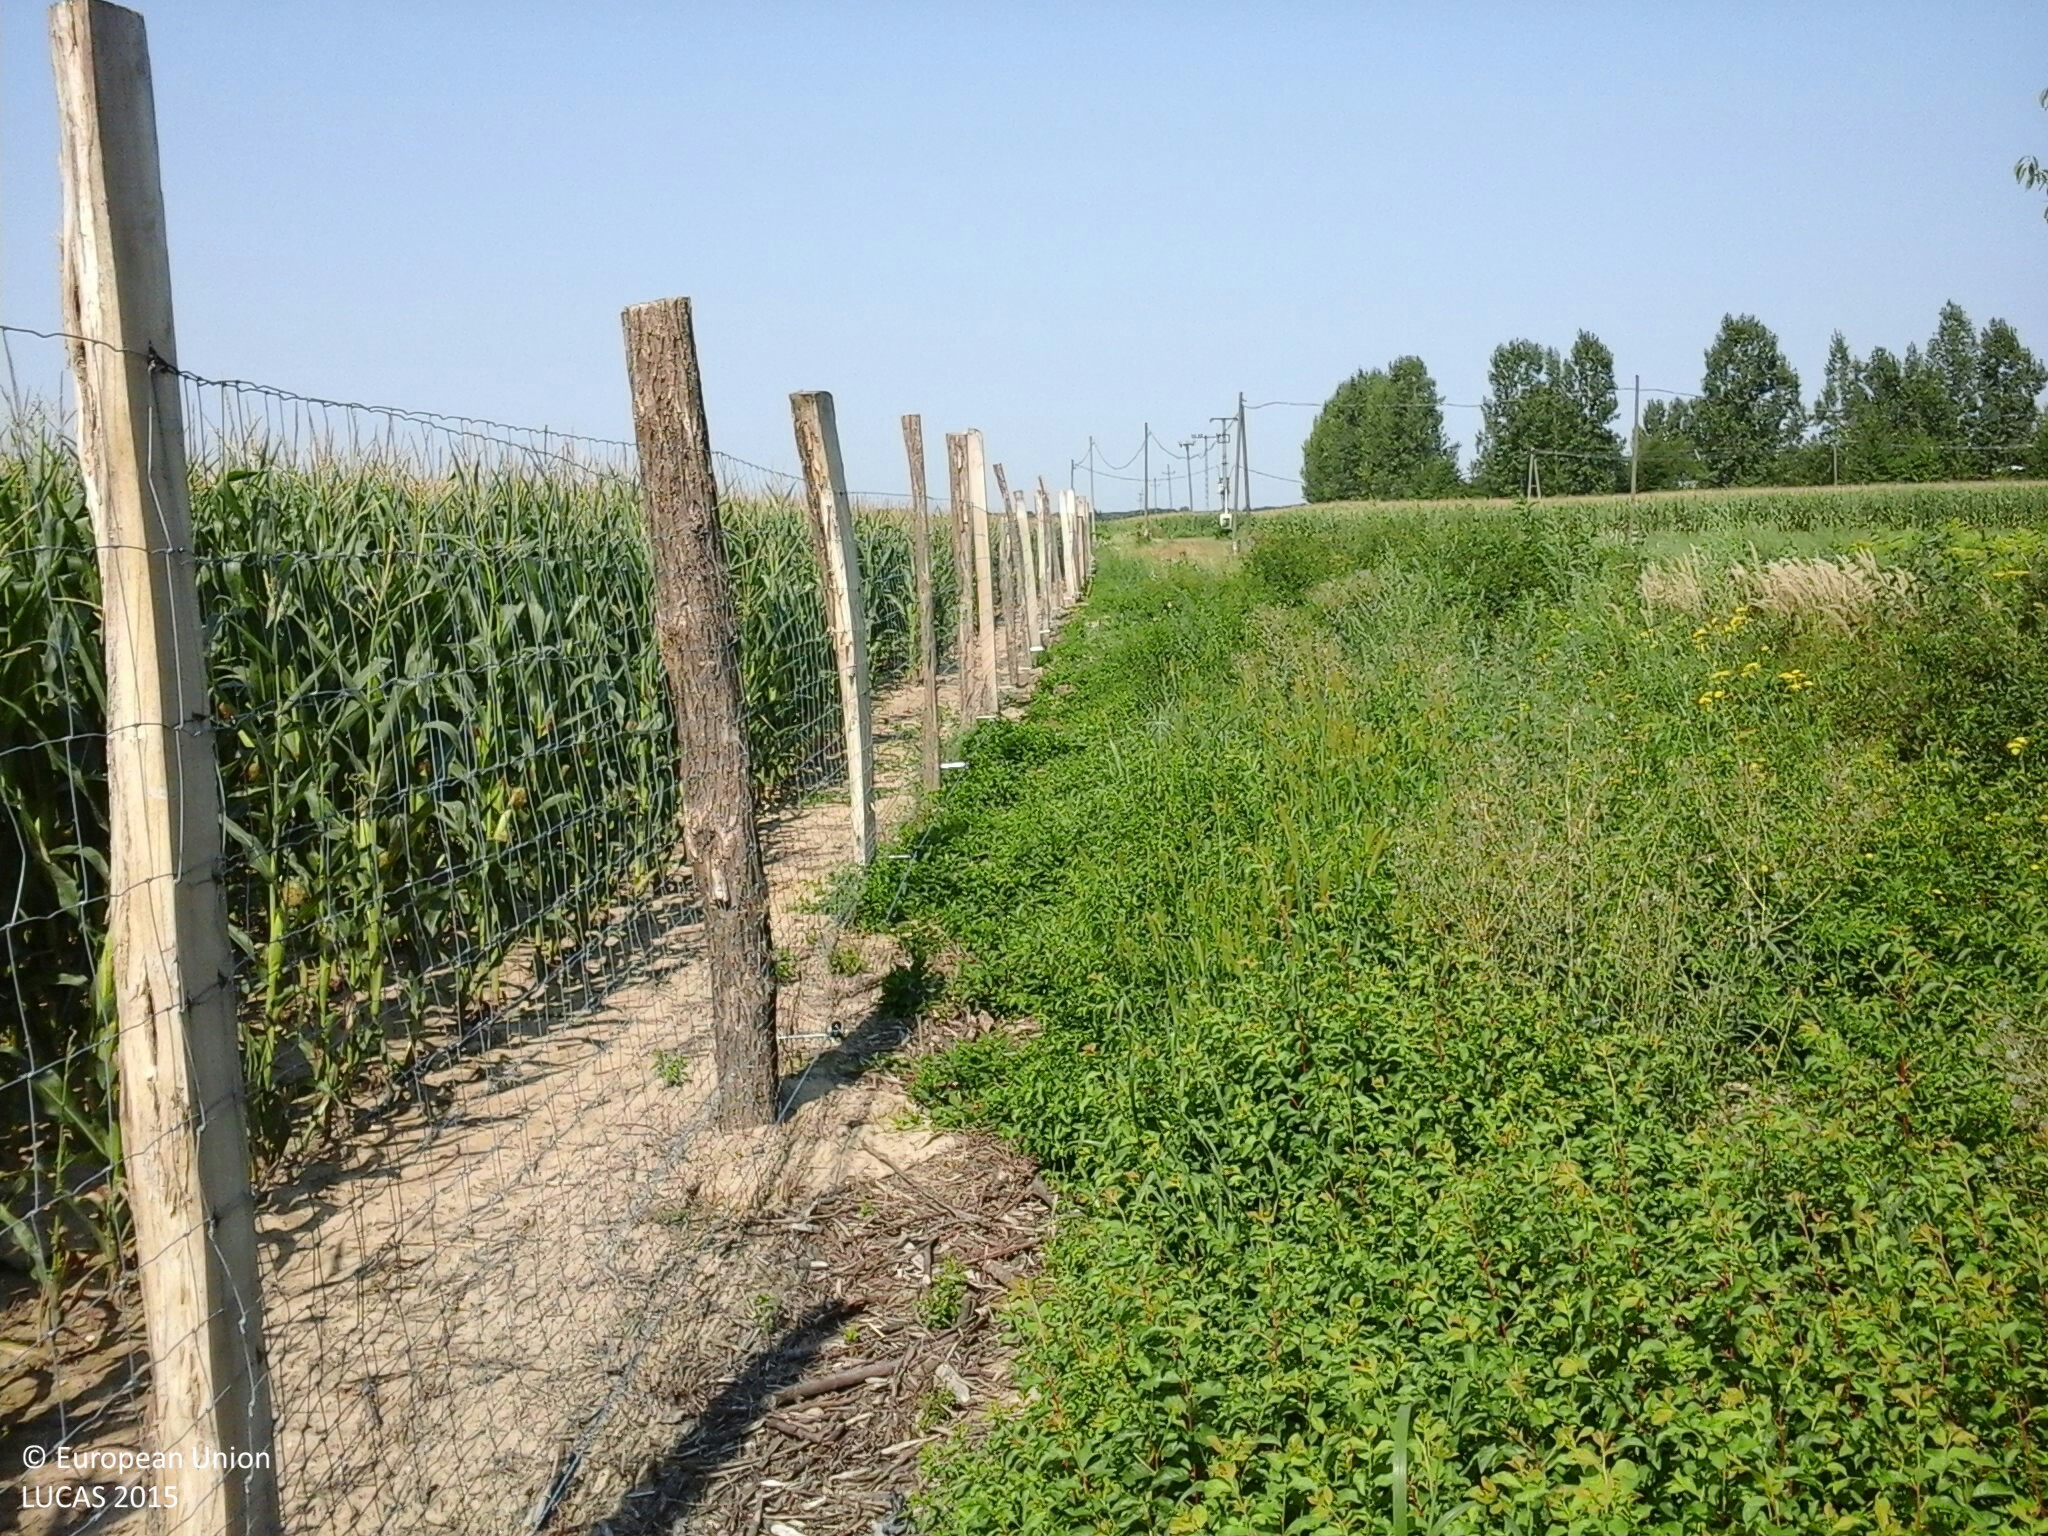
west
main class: Cropland
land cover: Maize
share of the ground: > 75 %
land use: Agriculture (excluding fallow land and kitchen gardens)
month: July
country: HU
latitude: 46.6743
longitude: 16.5509
